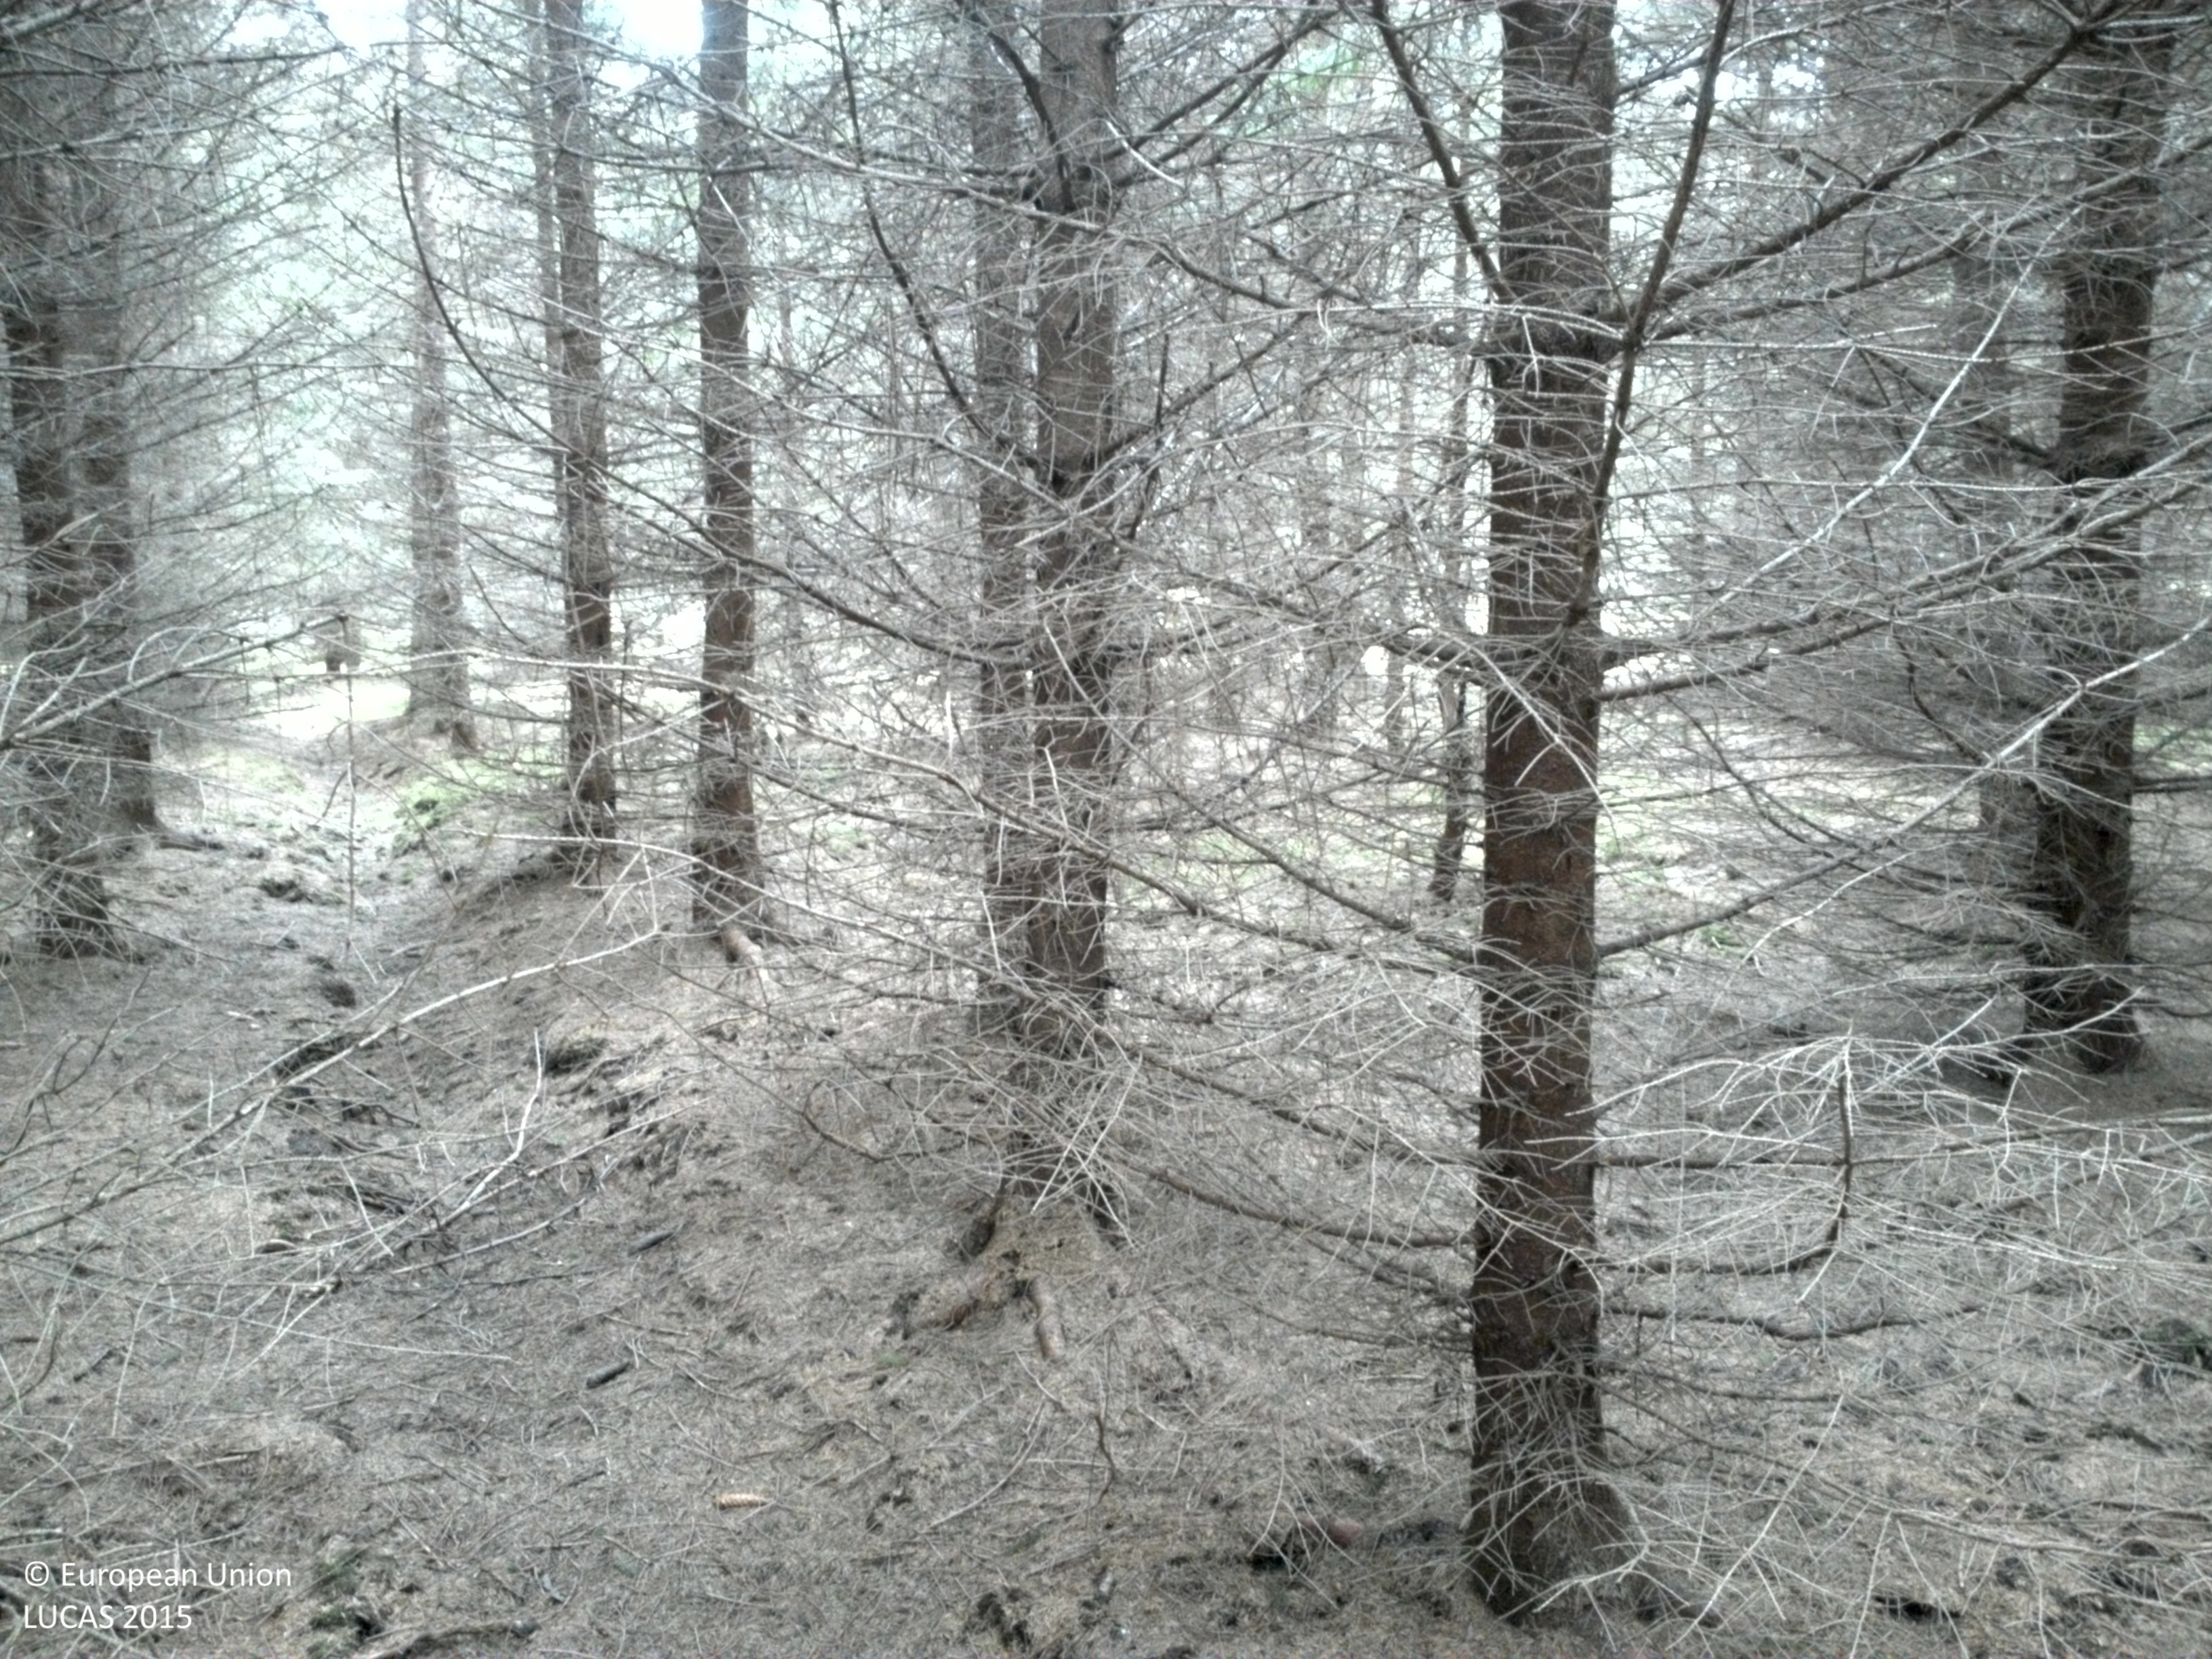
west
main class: Woodland
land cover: Spruce dominated coniferous woodland
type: boreal forest
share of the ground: > 75 %
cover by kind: coniferous forest trees 100 %
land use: Forestry
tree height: > 5 m
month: May
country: SE
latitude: 59.2545
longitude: 14.1481
